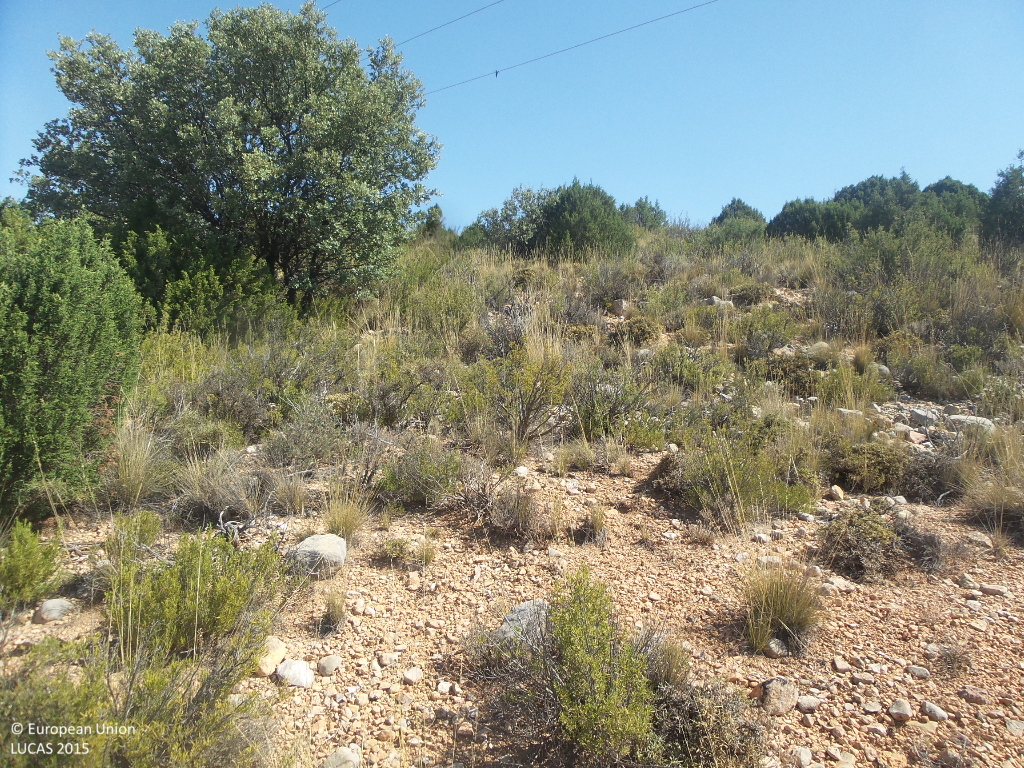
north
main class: Shrubland
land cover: Shrubland without tree cover
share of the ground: 50 - 75 %
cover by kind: shrubs 60 %, unconsolidated bare surface 35 %, herbaceous plants 5 %
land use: Semi-natural and natural areas not in use
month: July
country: ES
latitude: 41.1466
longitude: -1.9048
